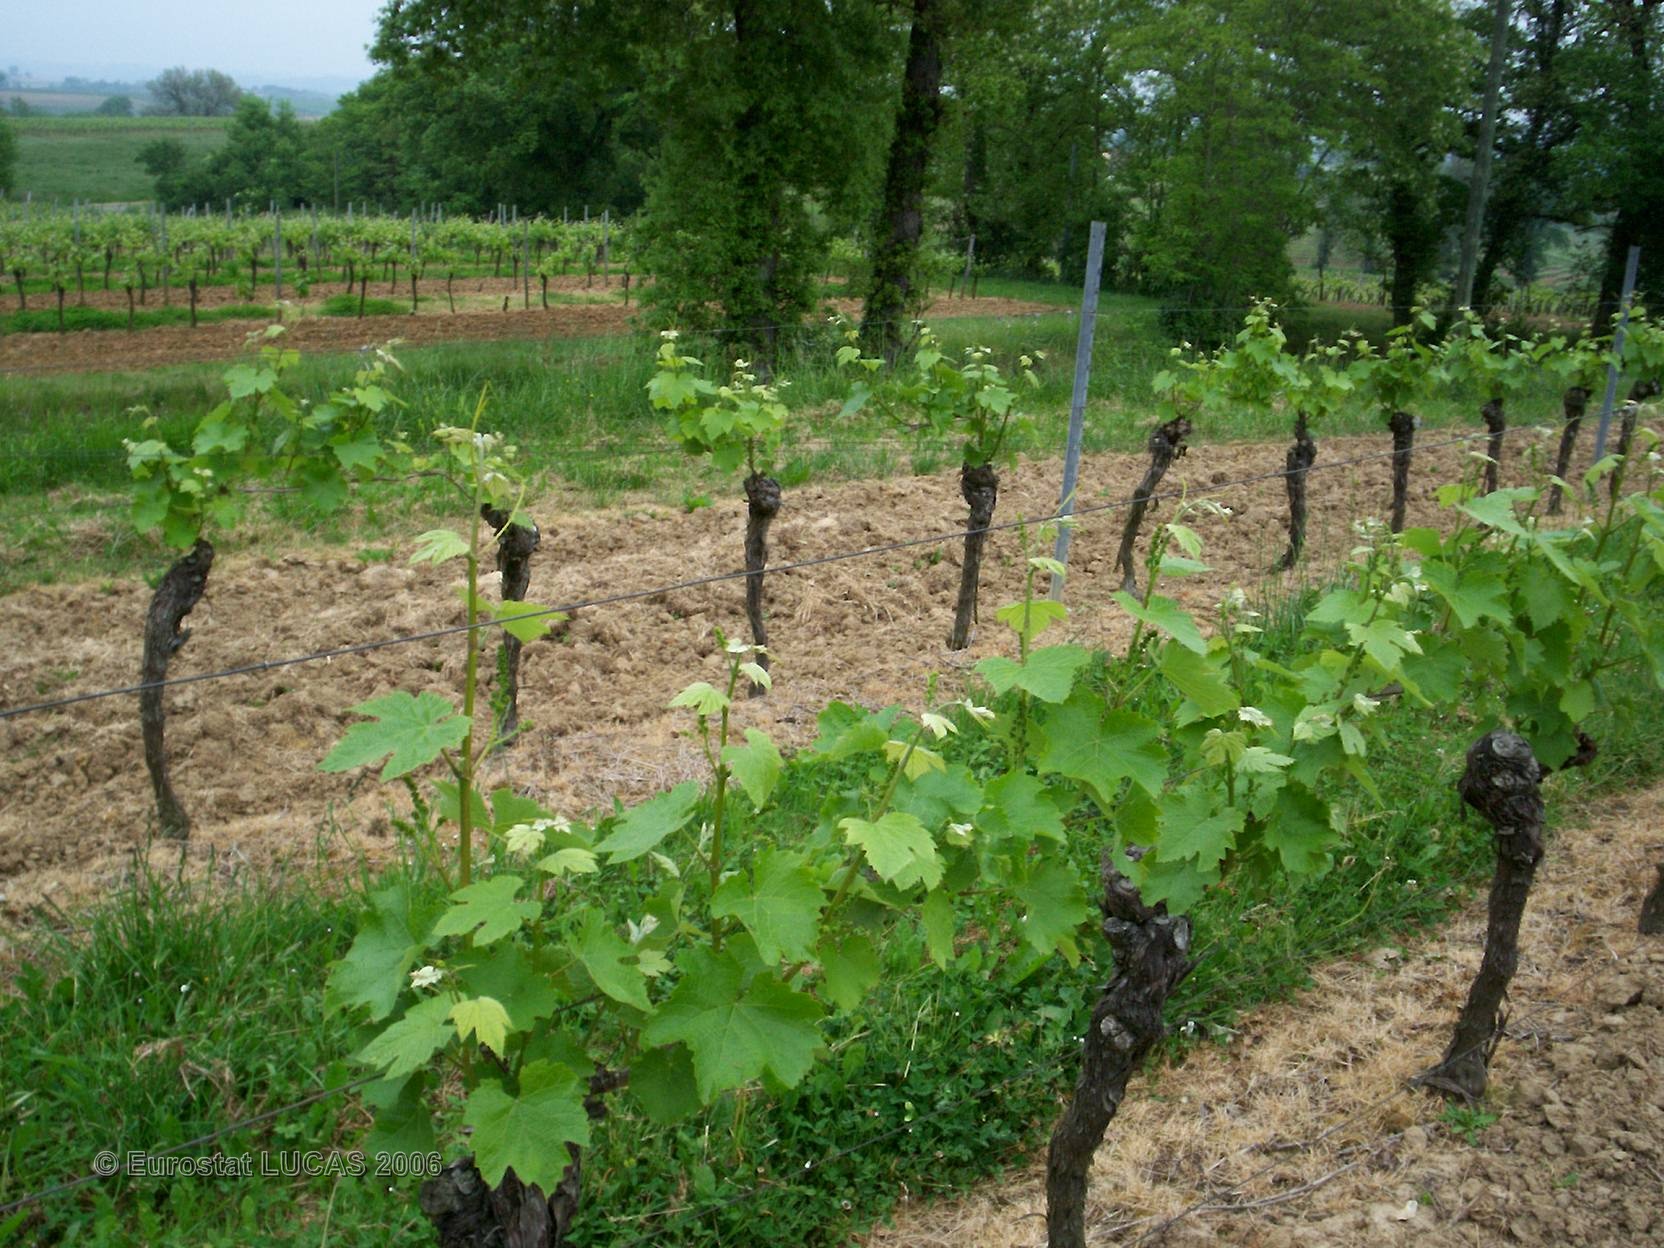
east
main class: Cropland
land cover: Vineyards
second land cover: Grassland with sparse tree/shrub cover
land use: Agriculture (excluding fallow land and kitchen gardens)
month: May
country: FR
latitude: 43.8723
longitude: 0.2503
